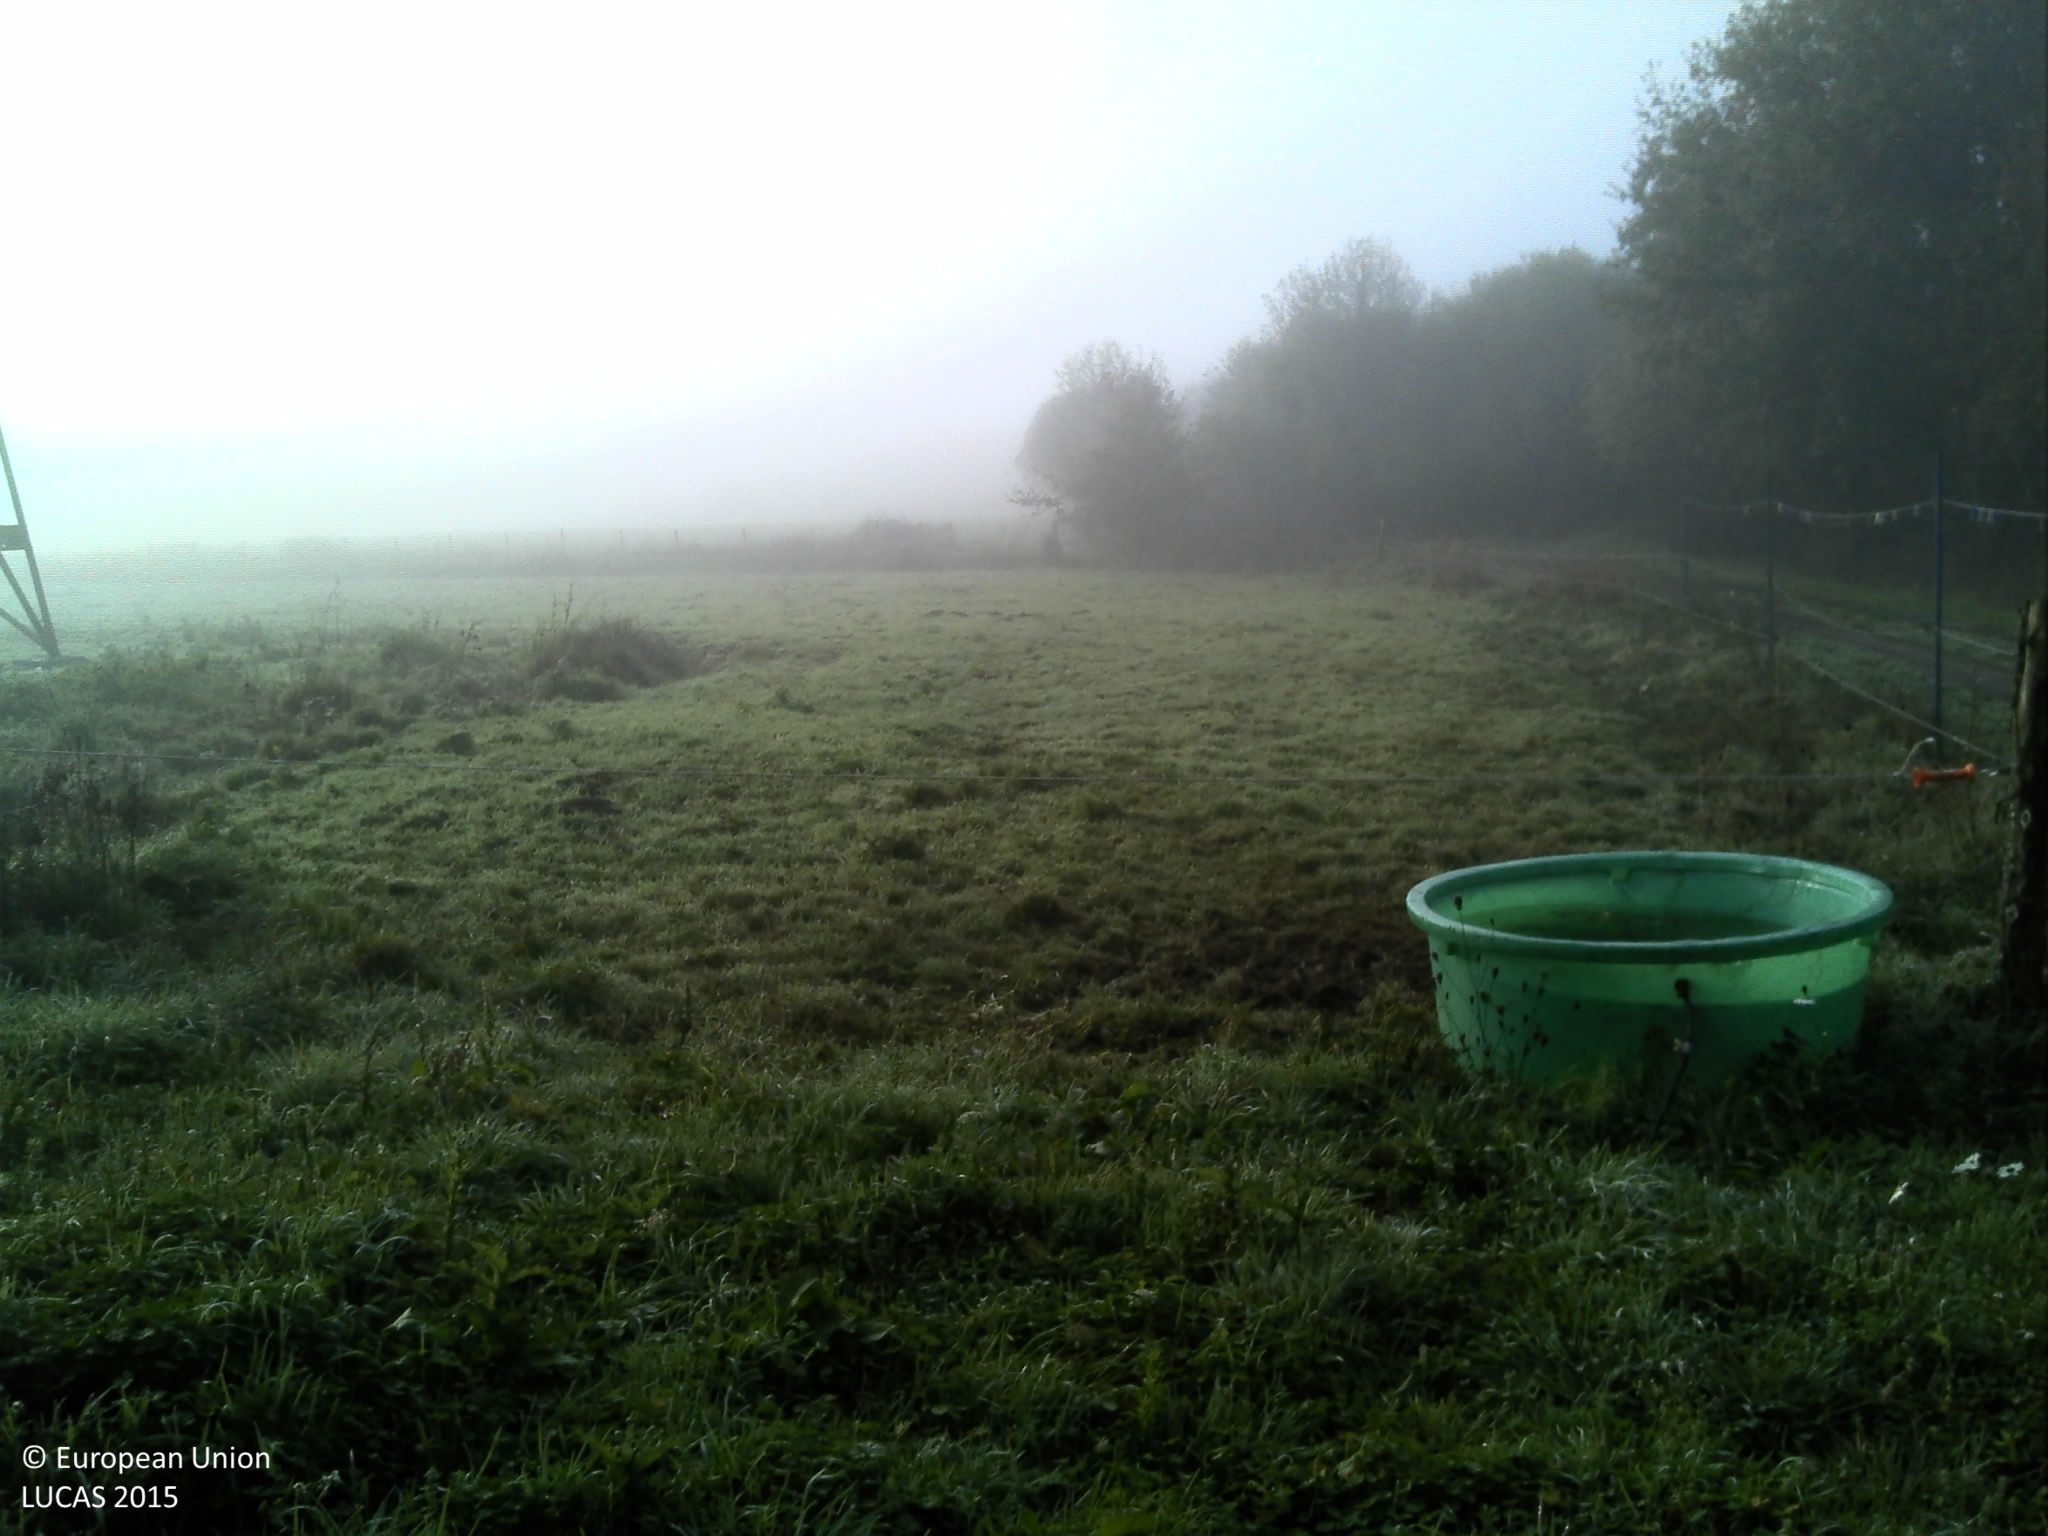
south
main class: Grassland
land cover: Grassland with sparse tree/shrub cover
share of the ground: > 75 %
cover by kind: herbaceous plants 95 %, coniferous forest trees 5 %
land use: Residential
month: November
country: FR
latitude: 47.3493
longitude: -1.8144
